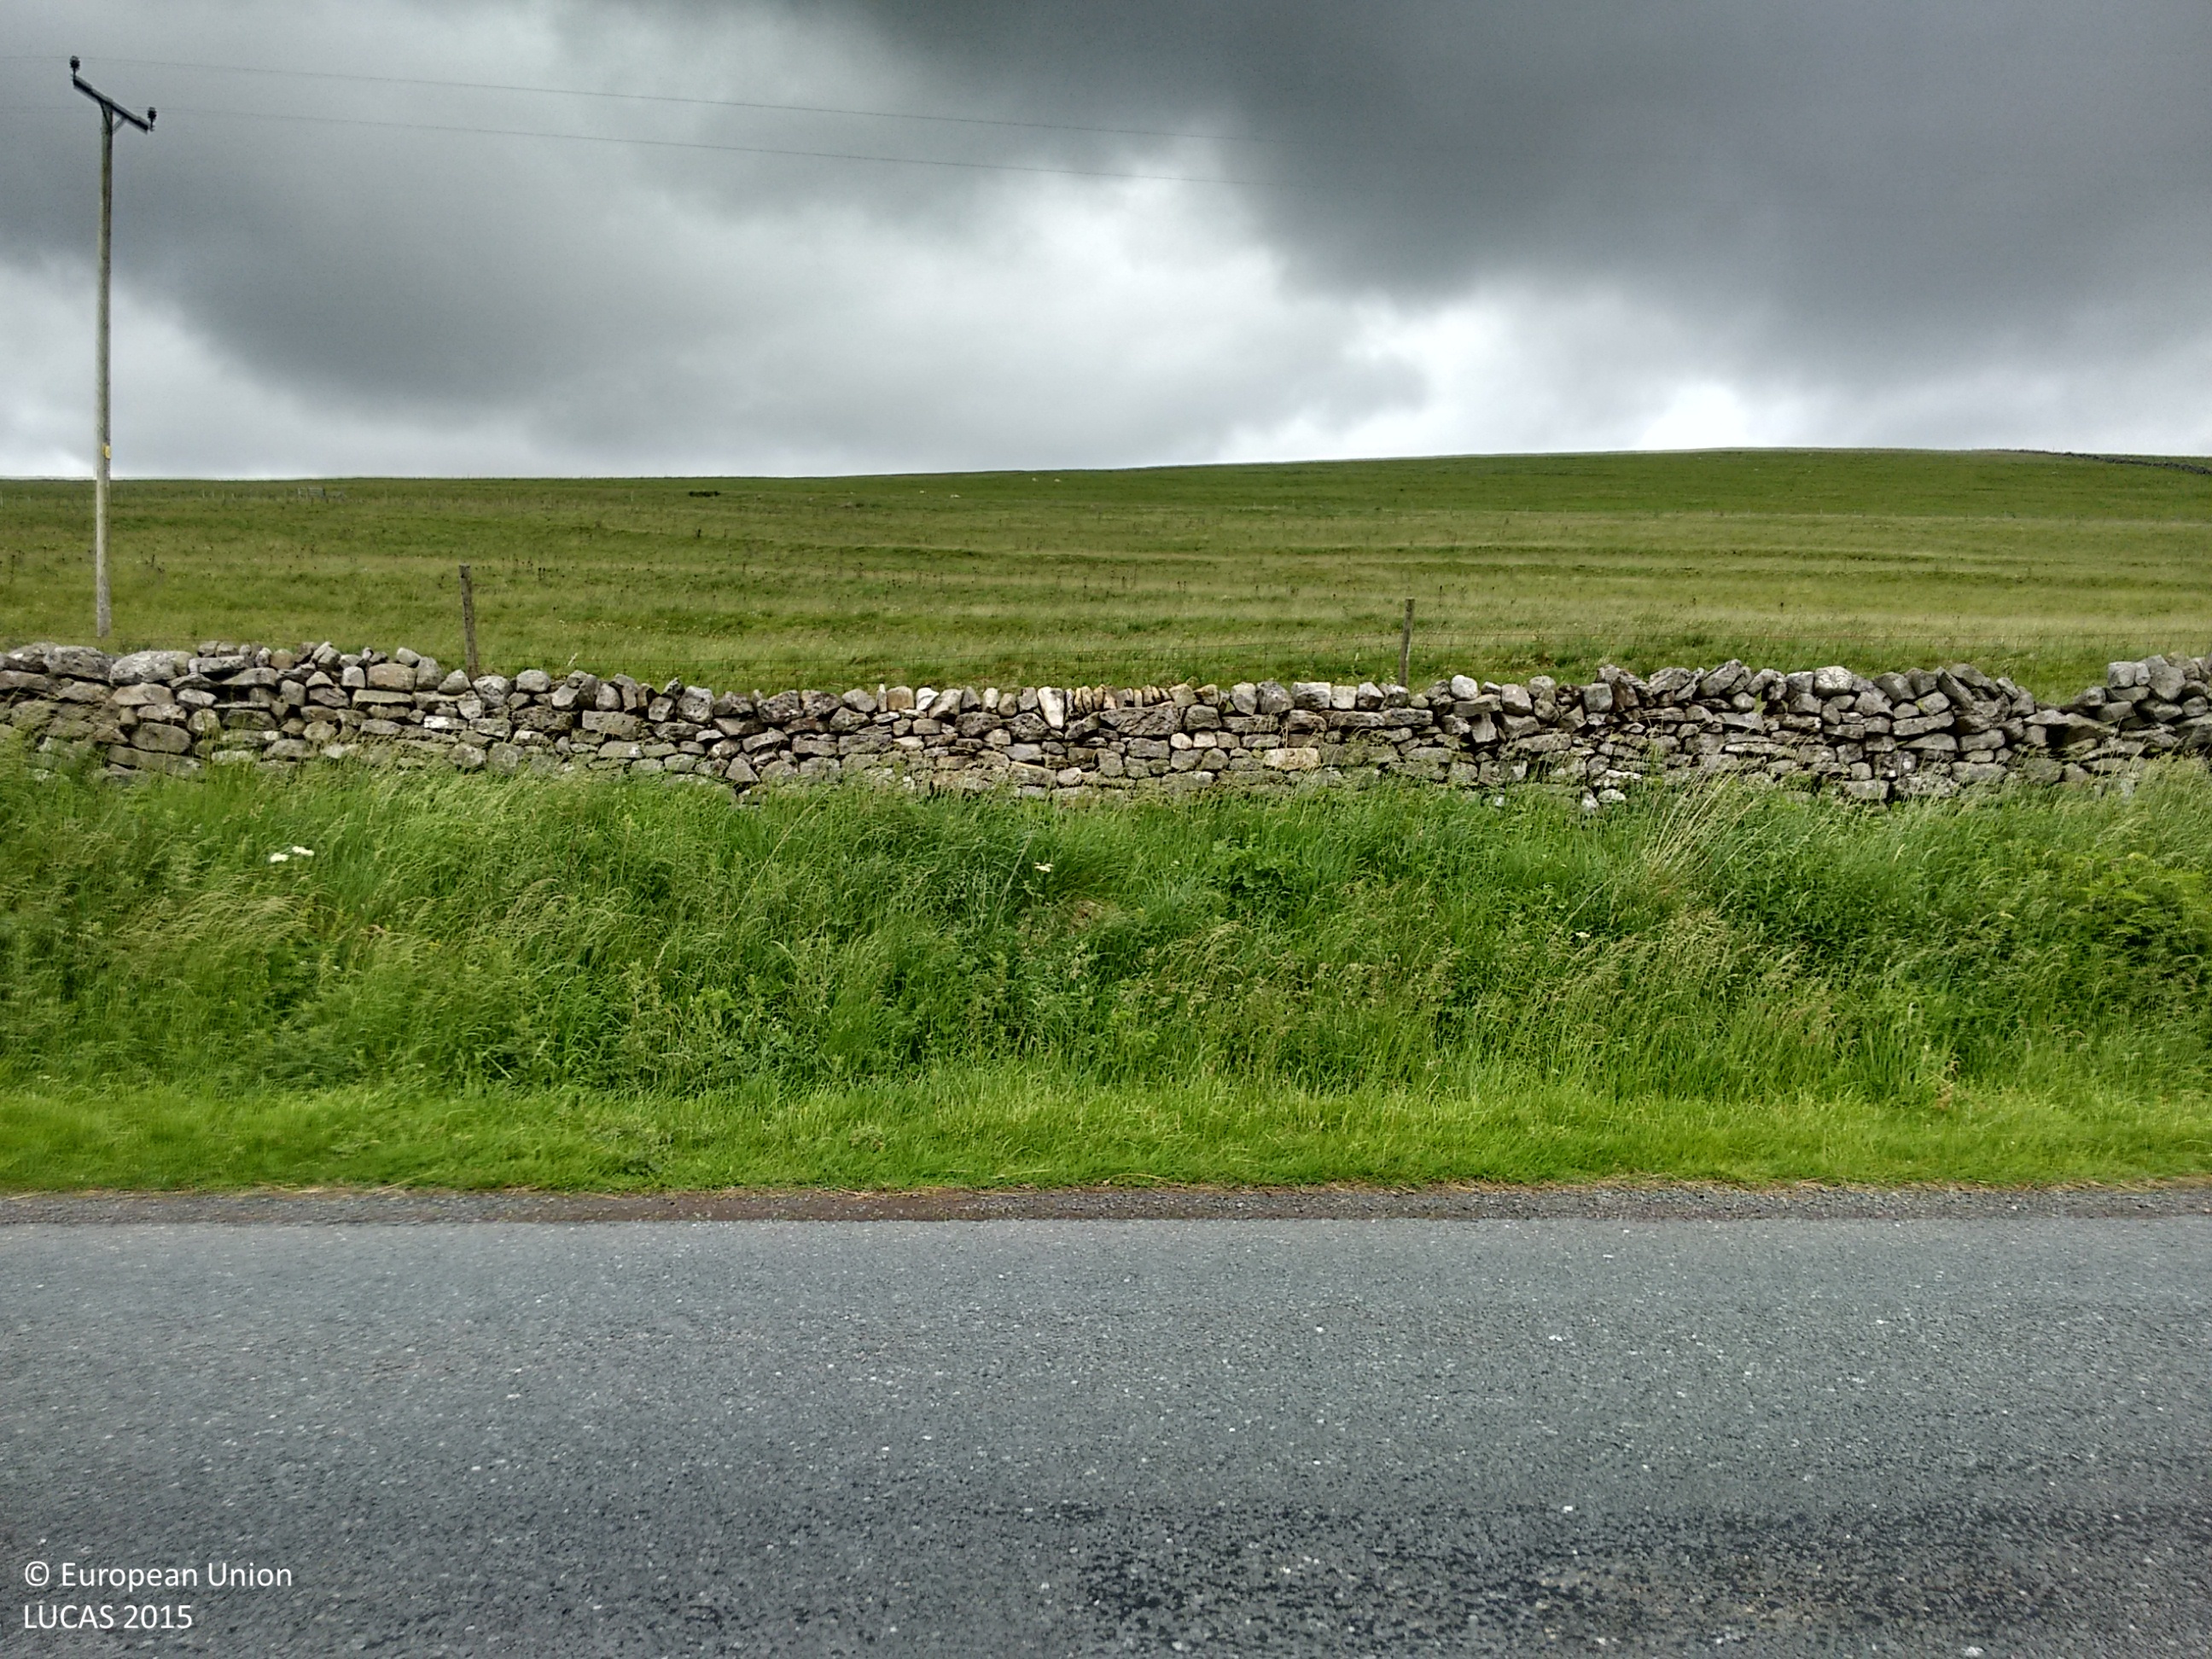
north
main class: Grassland
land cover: Grassland without tree/shrub cover
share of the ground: > 75 %
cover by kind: herbaceous plants 100 %
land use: Water supply and treatment
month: July
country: GB
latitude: 54.5892
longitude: -2.1439
